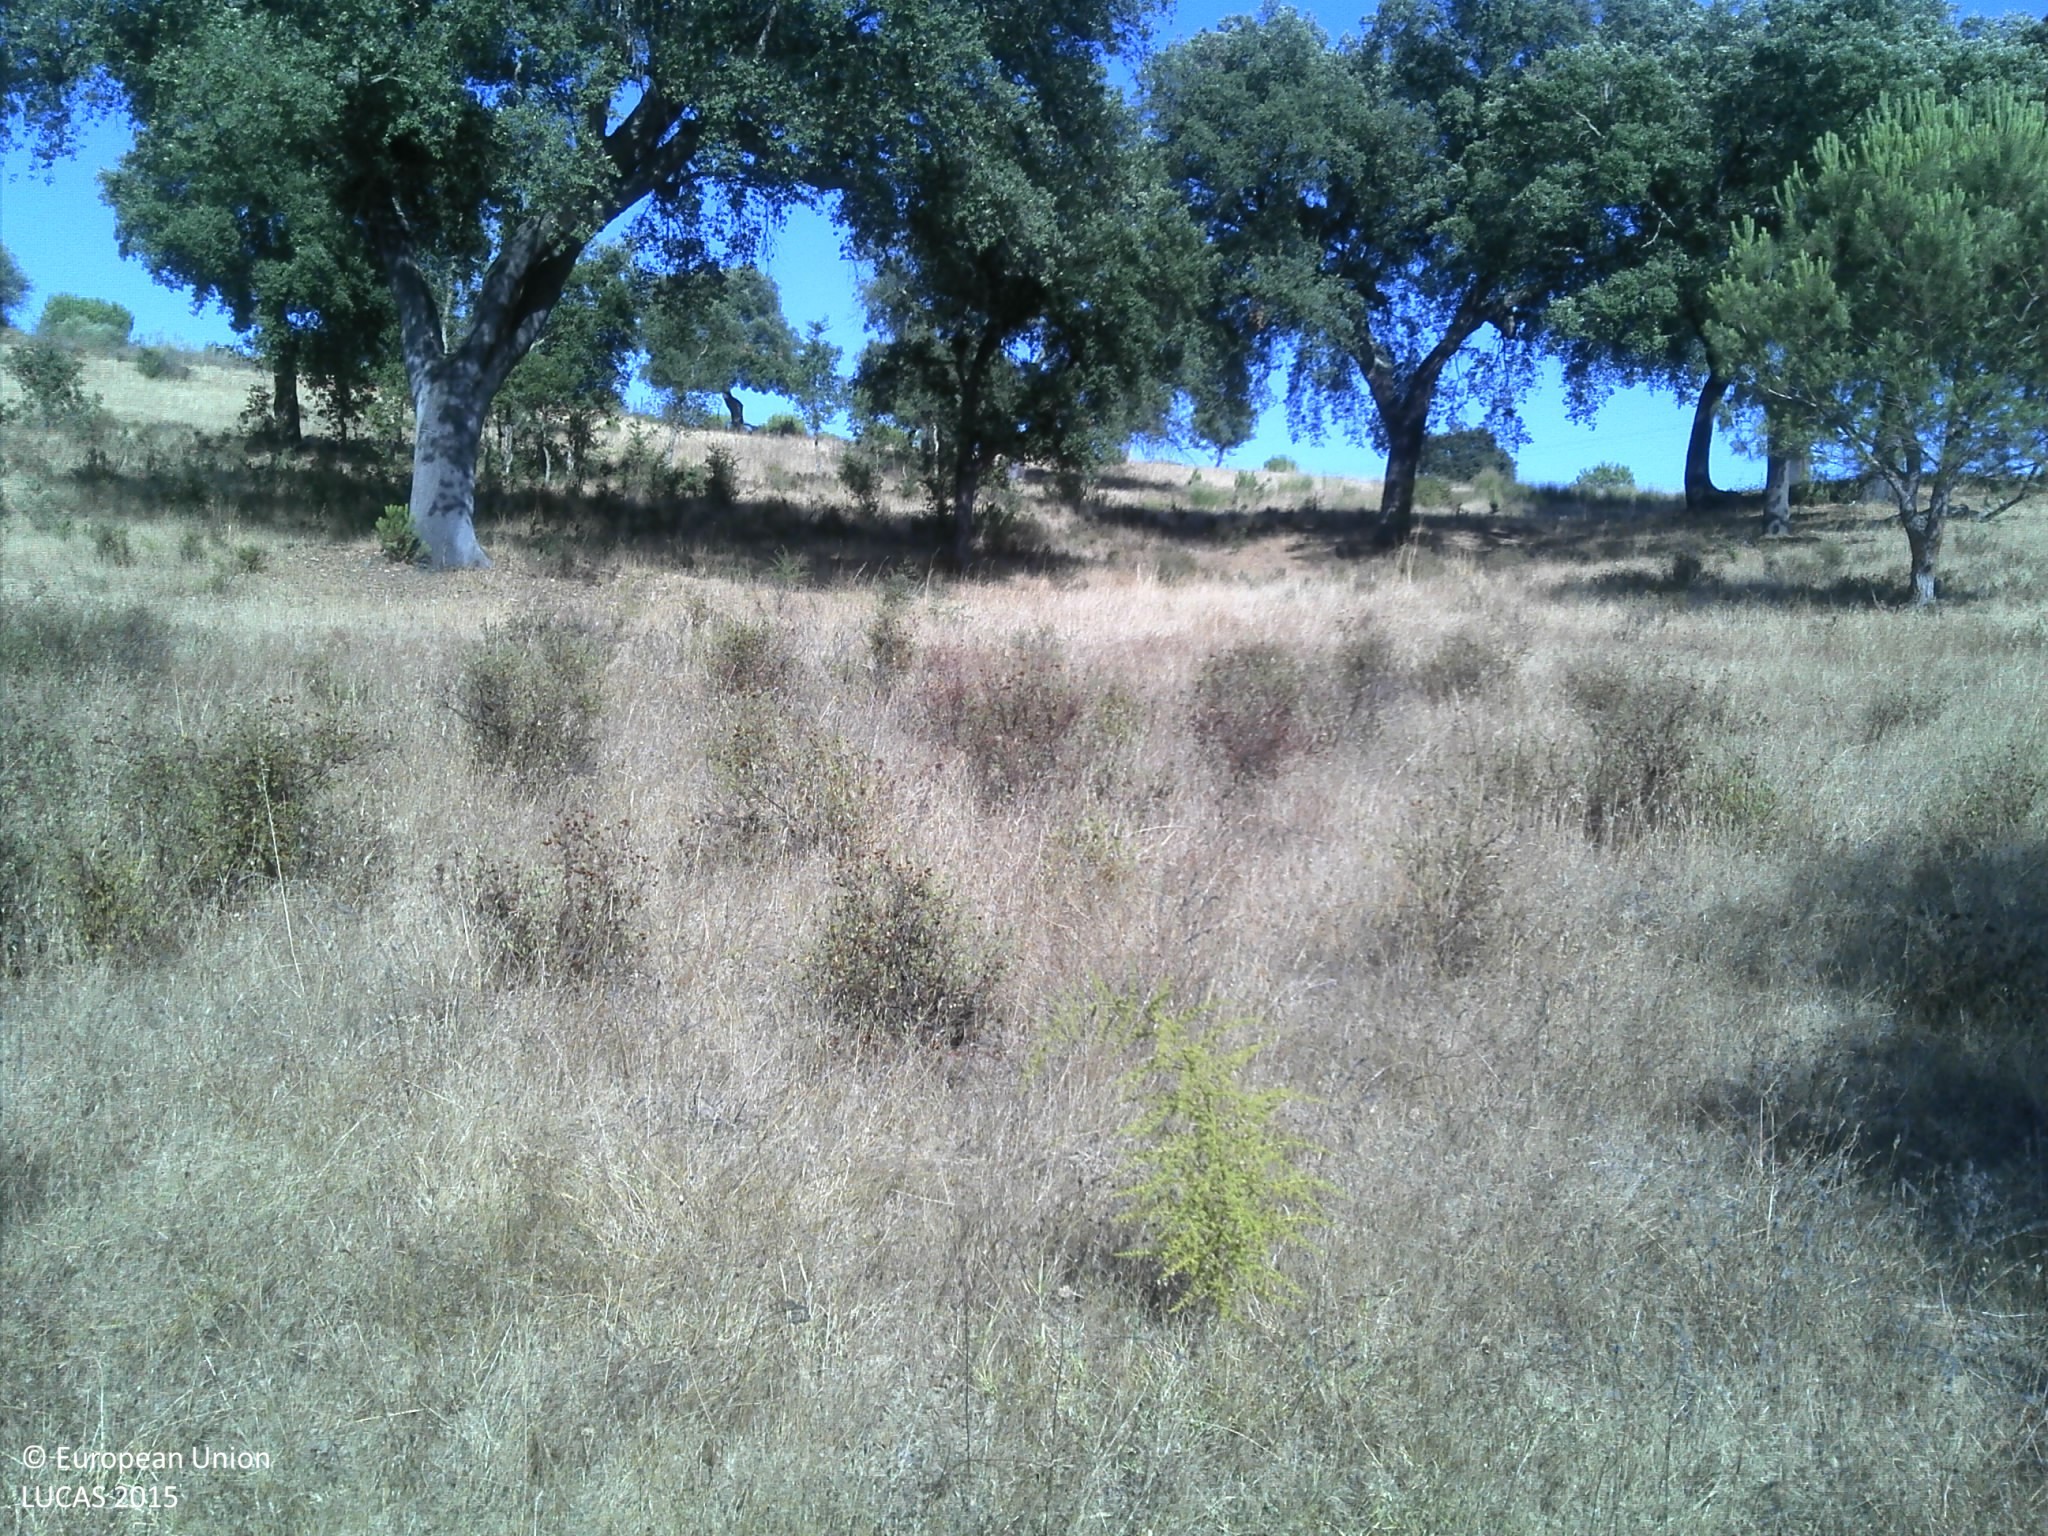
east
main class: Woodland
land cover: Broadleaved woodland
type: broadleaved evergreen forest
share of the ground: 25 - 50 %
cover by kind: broadleaved forest trees 40 %, unconsolidated bare surface 35 %, herbaceous plants 20 %, shrubs 5 %
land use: Forestry
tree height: > 5 m
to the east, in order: Broadleaved woodland; Grassland without tree/shrub cover; Fences; Grass margins; Paved roads, cycling and walking lanes; Grass margins; Fences; Other bare soil; Pine dominated coniferous woodland
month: July
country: PT
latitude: 38.9721
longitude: -8.2106
